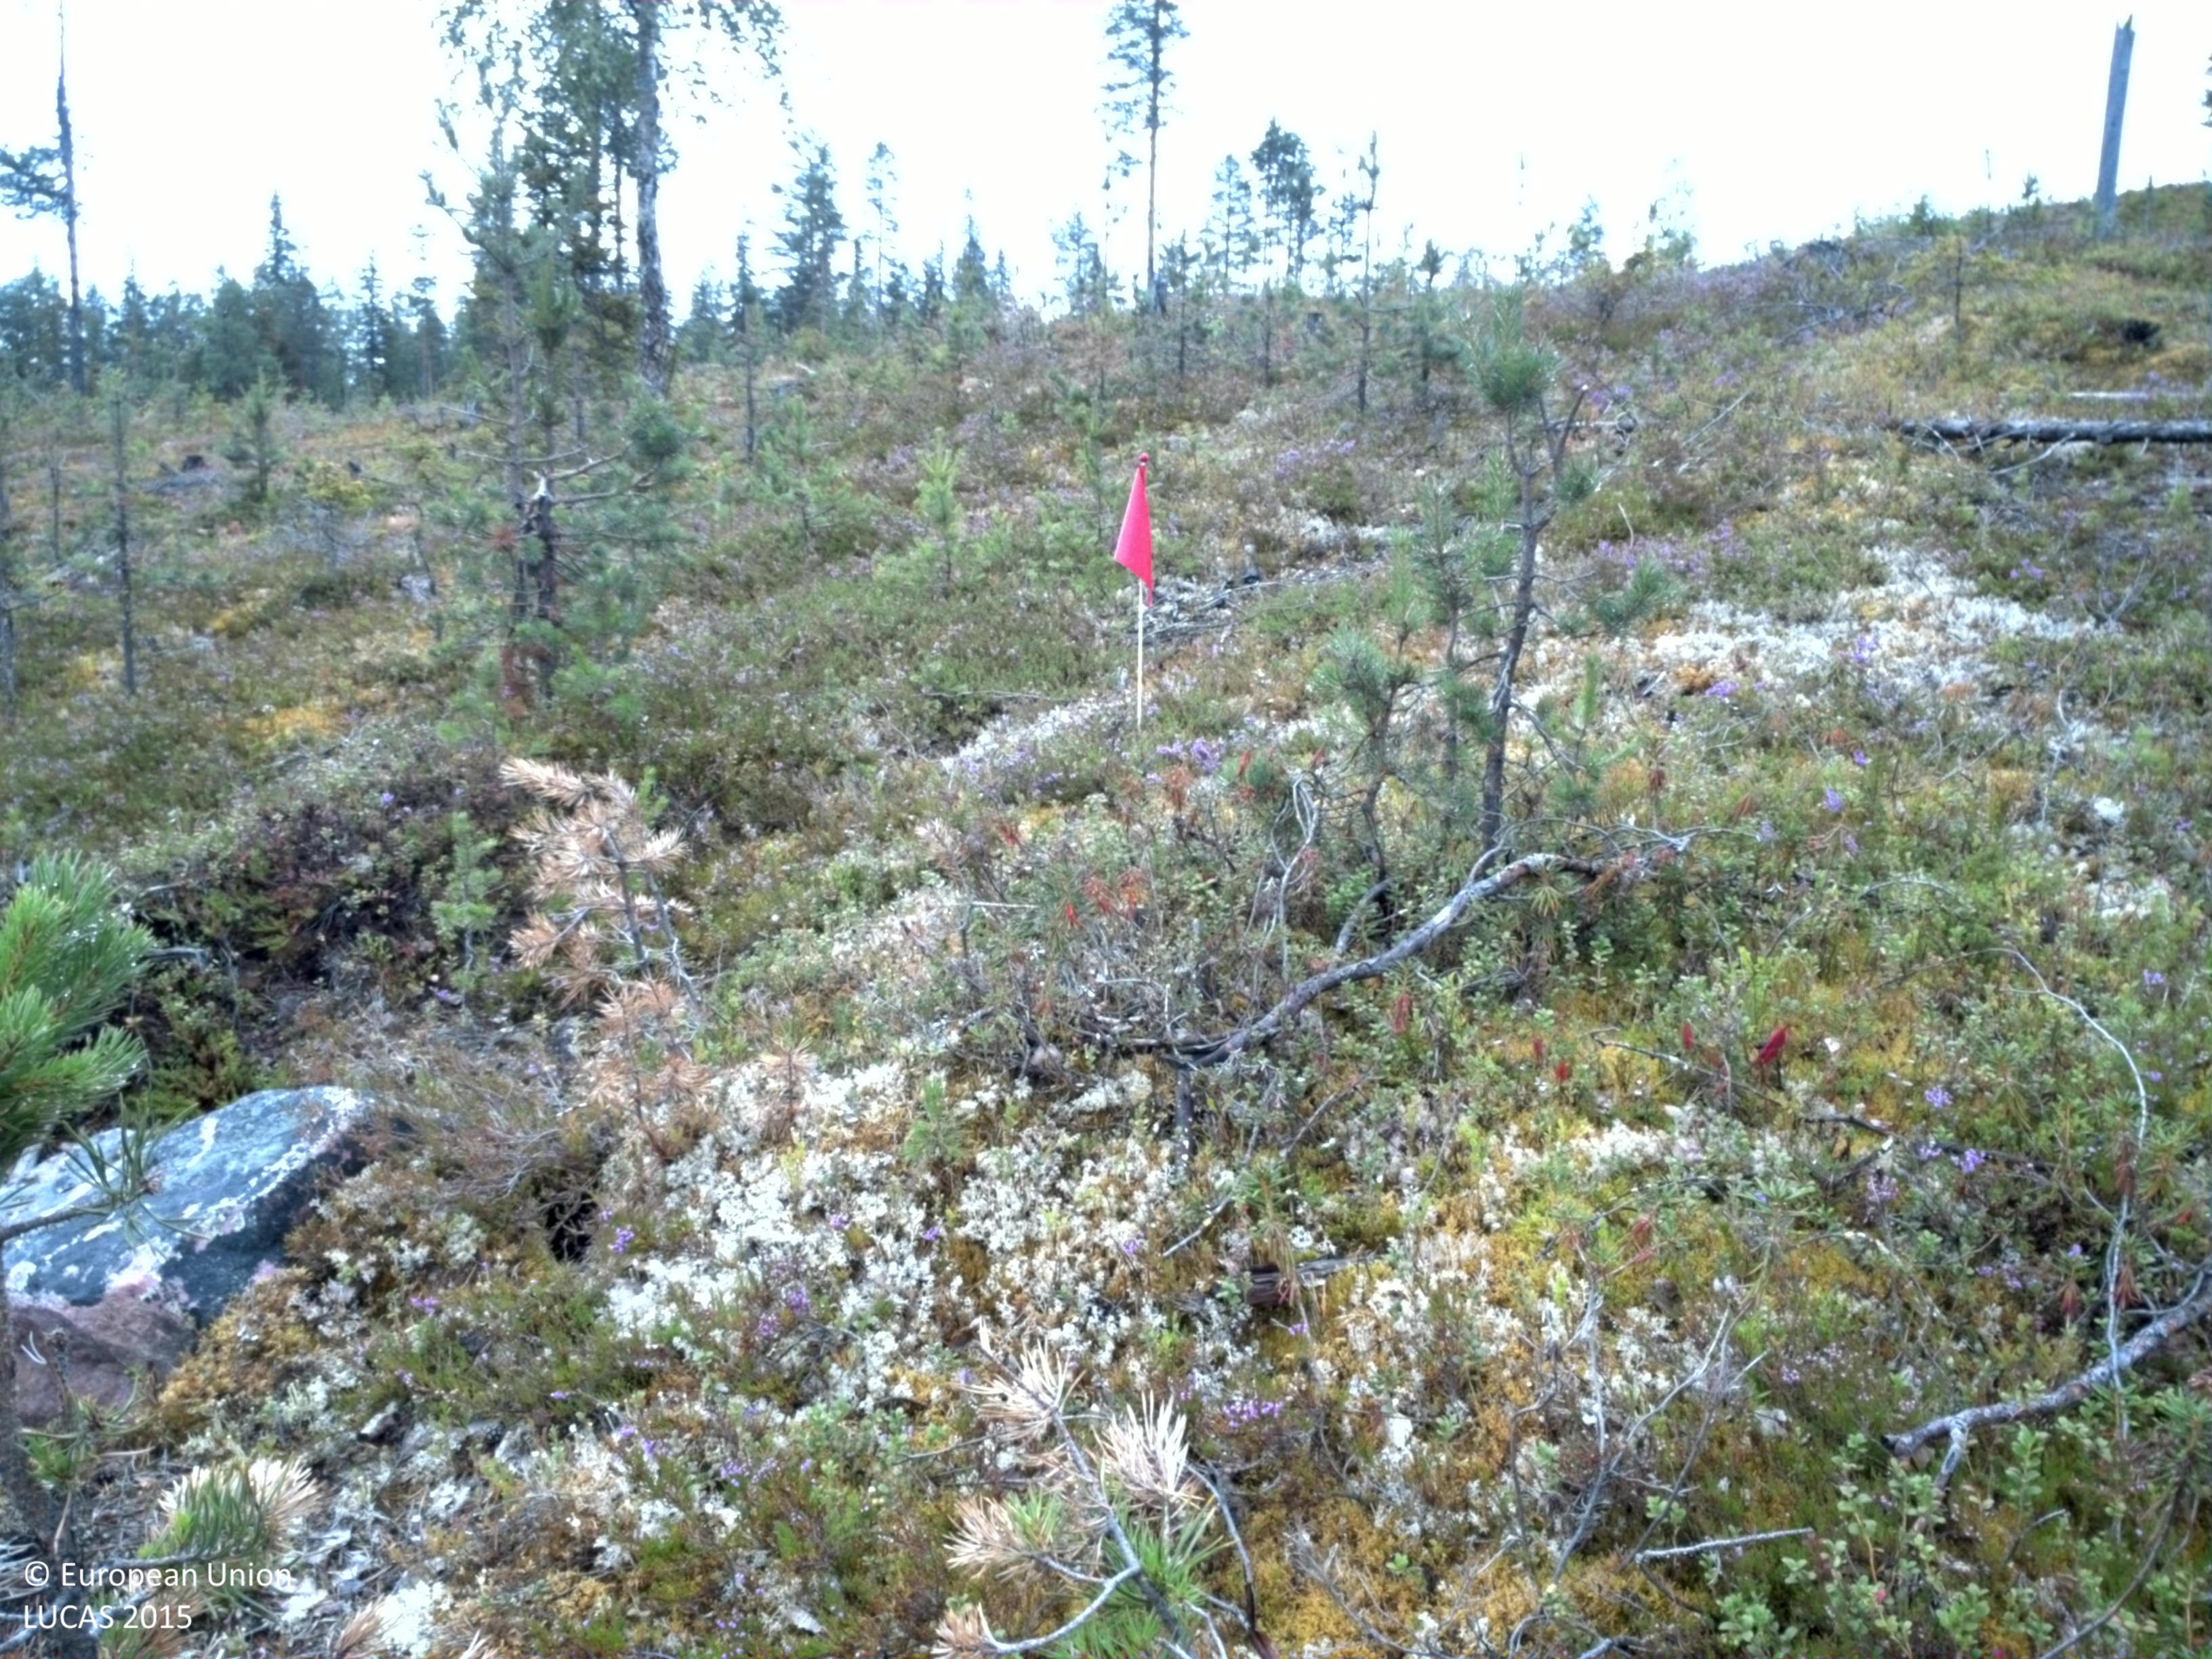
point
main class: Woodland
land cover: Pine dominated coniferous woodland
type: boreal forest
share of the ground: 10 - 25 %
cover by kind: shrubs 80 %, coniferous forest trees 10 %, lichens and mosses 10 %
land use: Forestry
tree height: < 5 m
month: August
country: SE
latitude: 66.4591
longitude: 20.5247
